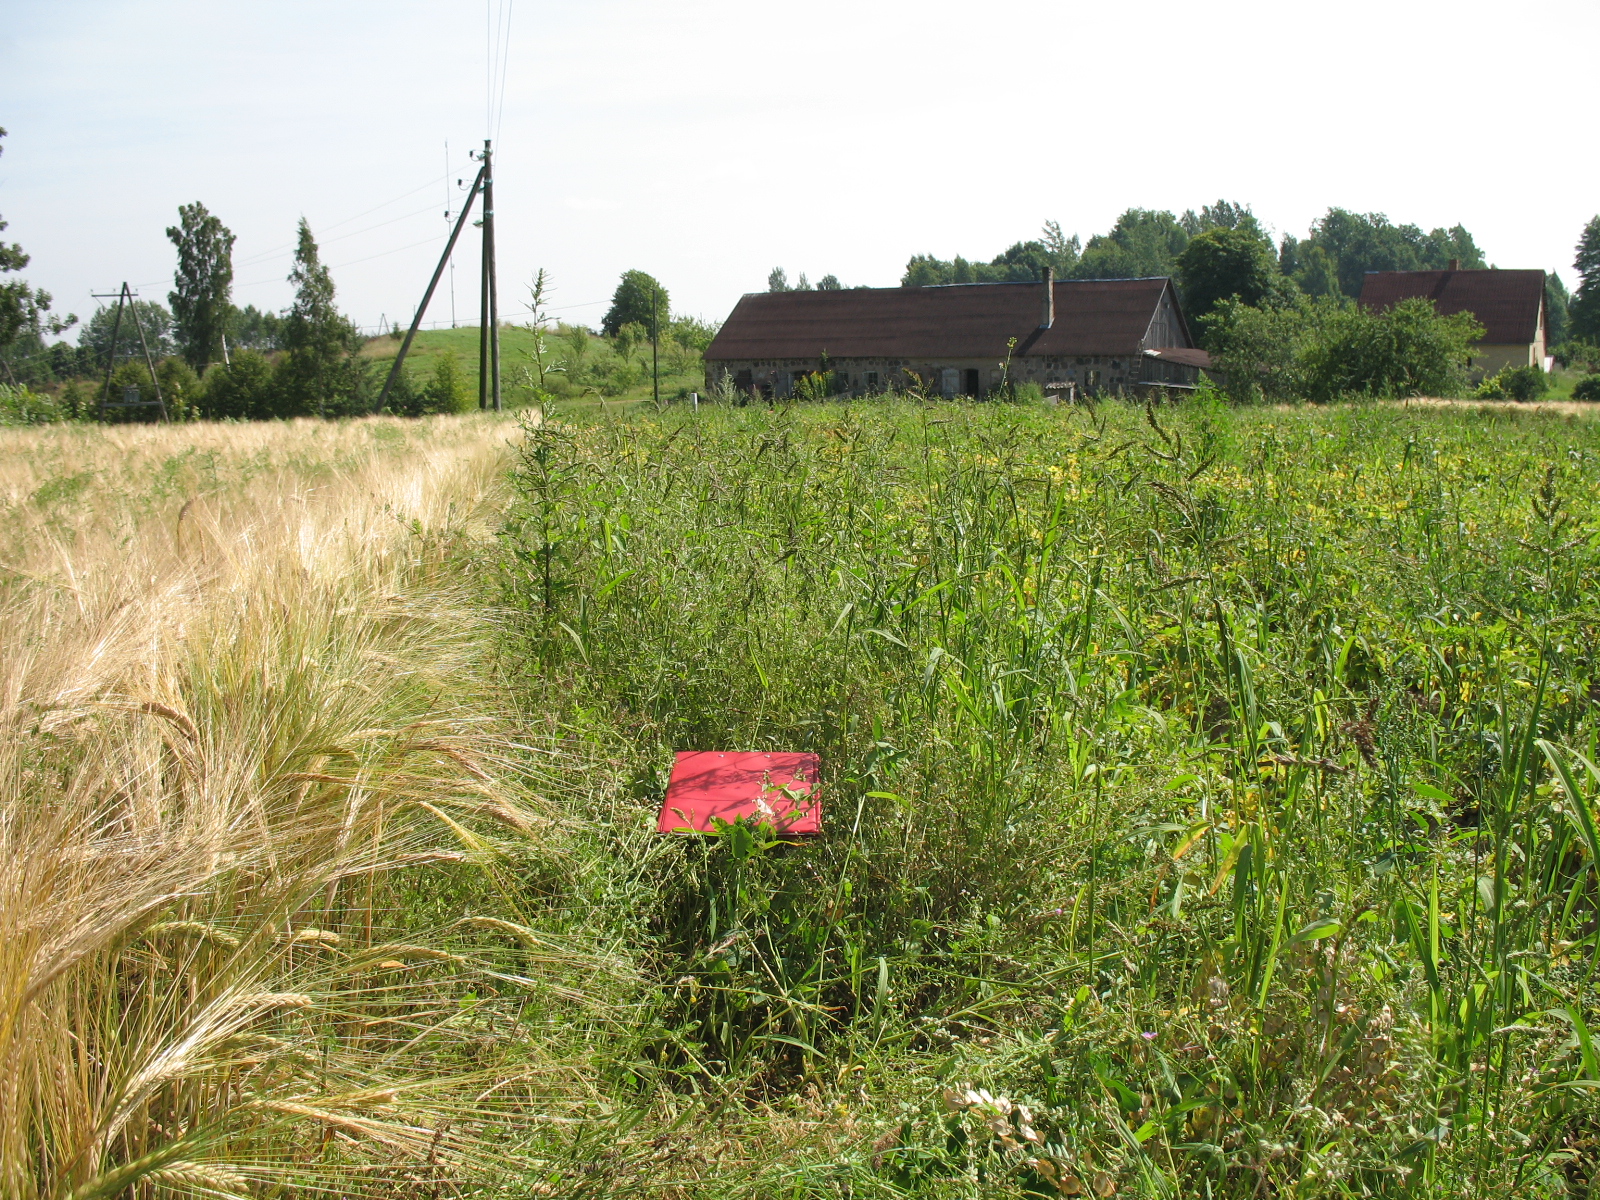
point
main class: Cropland
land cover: Barley
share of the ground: > 75 %
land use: Agriculture (excluding fallow land and kitchen gardens)
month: August
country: LV
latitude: 56.4080
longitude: 25.5334
